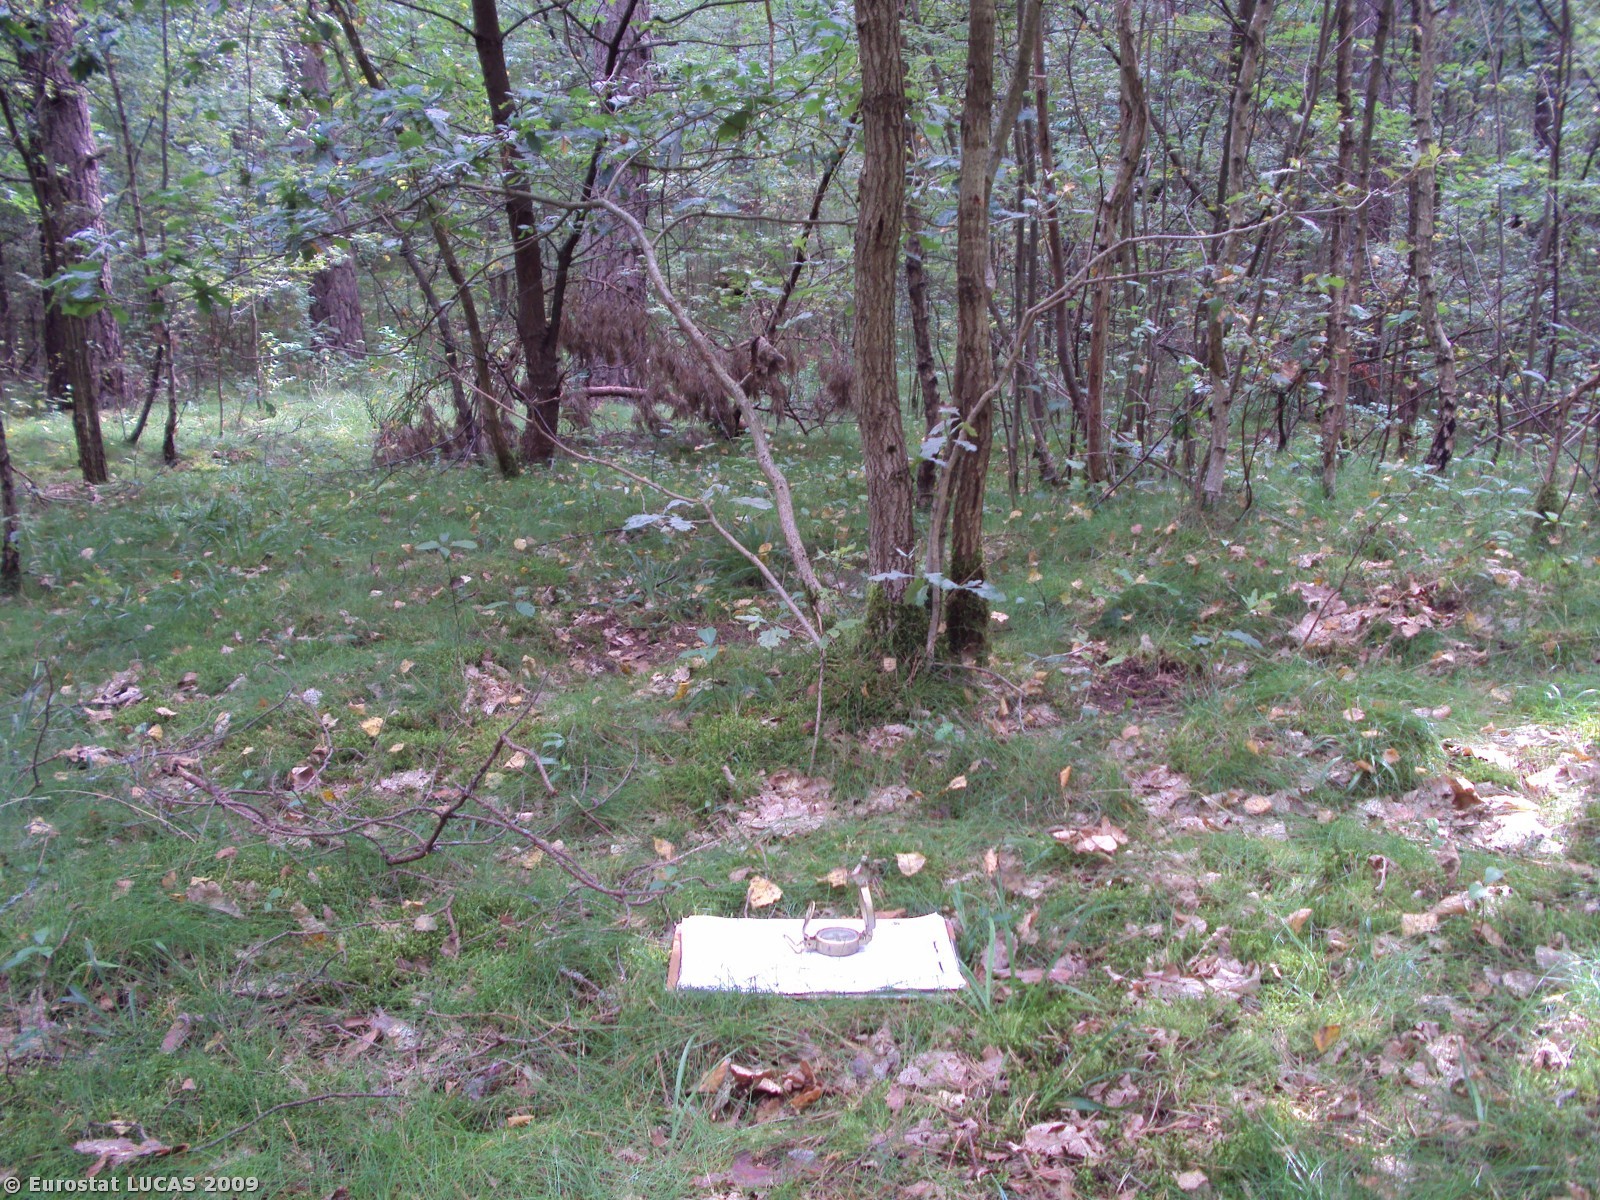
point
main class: Woodland
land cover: Mixed woodland
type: hemiboreal forest and nemoral coniferous forest and mixed broadleaved-coniferous forest
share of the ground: > 75 %
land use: Forestry
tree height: > 5 m
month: August
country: PL
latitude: 53.5871
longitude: 16.5177
